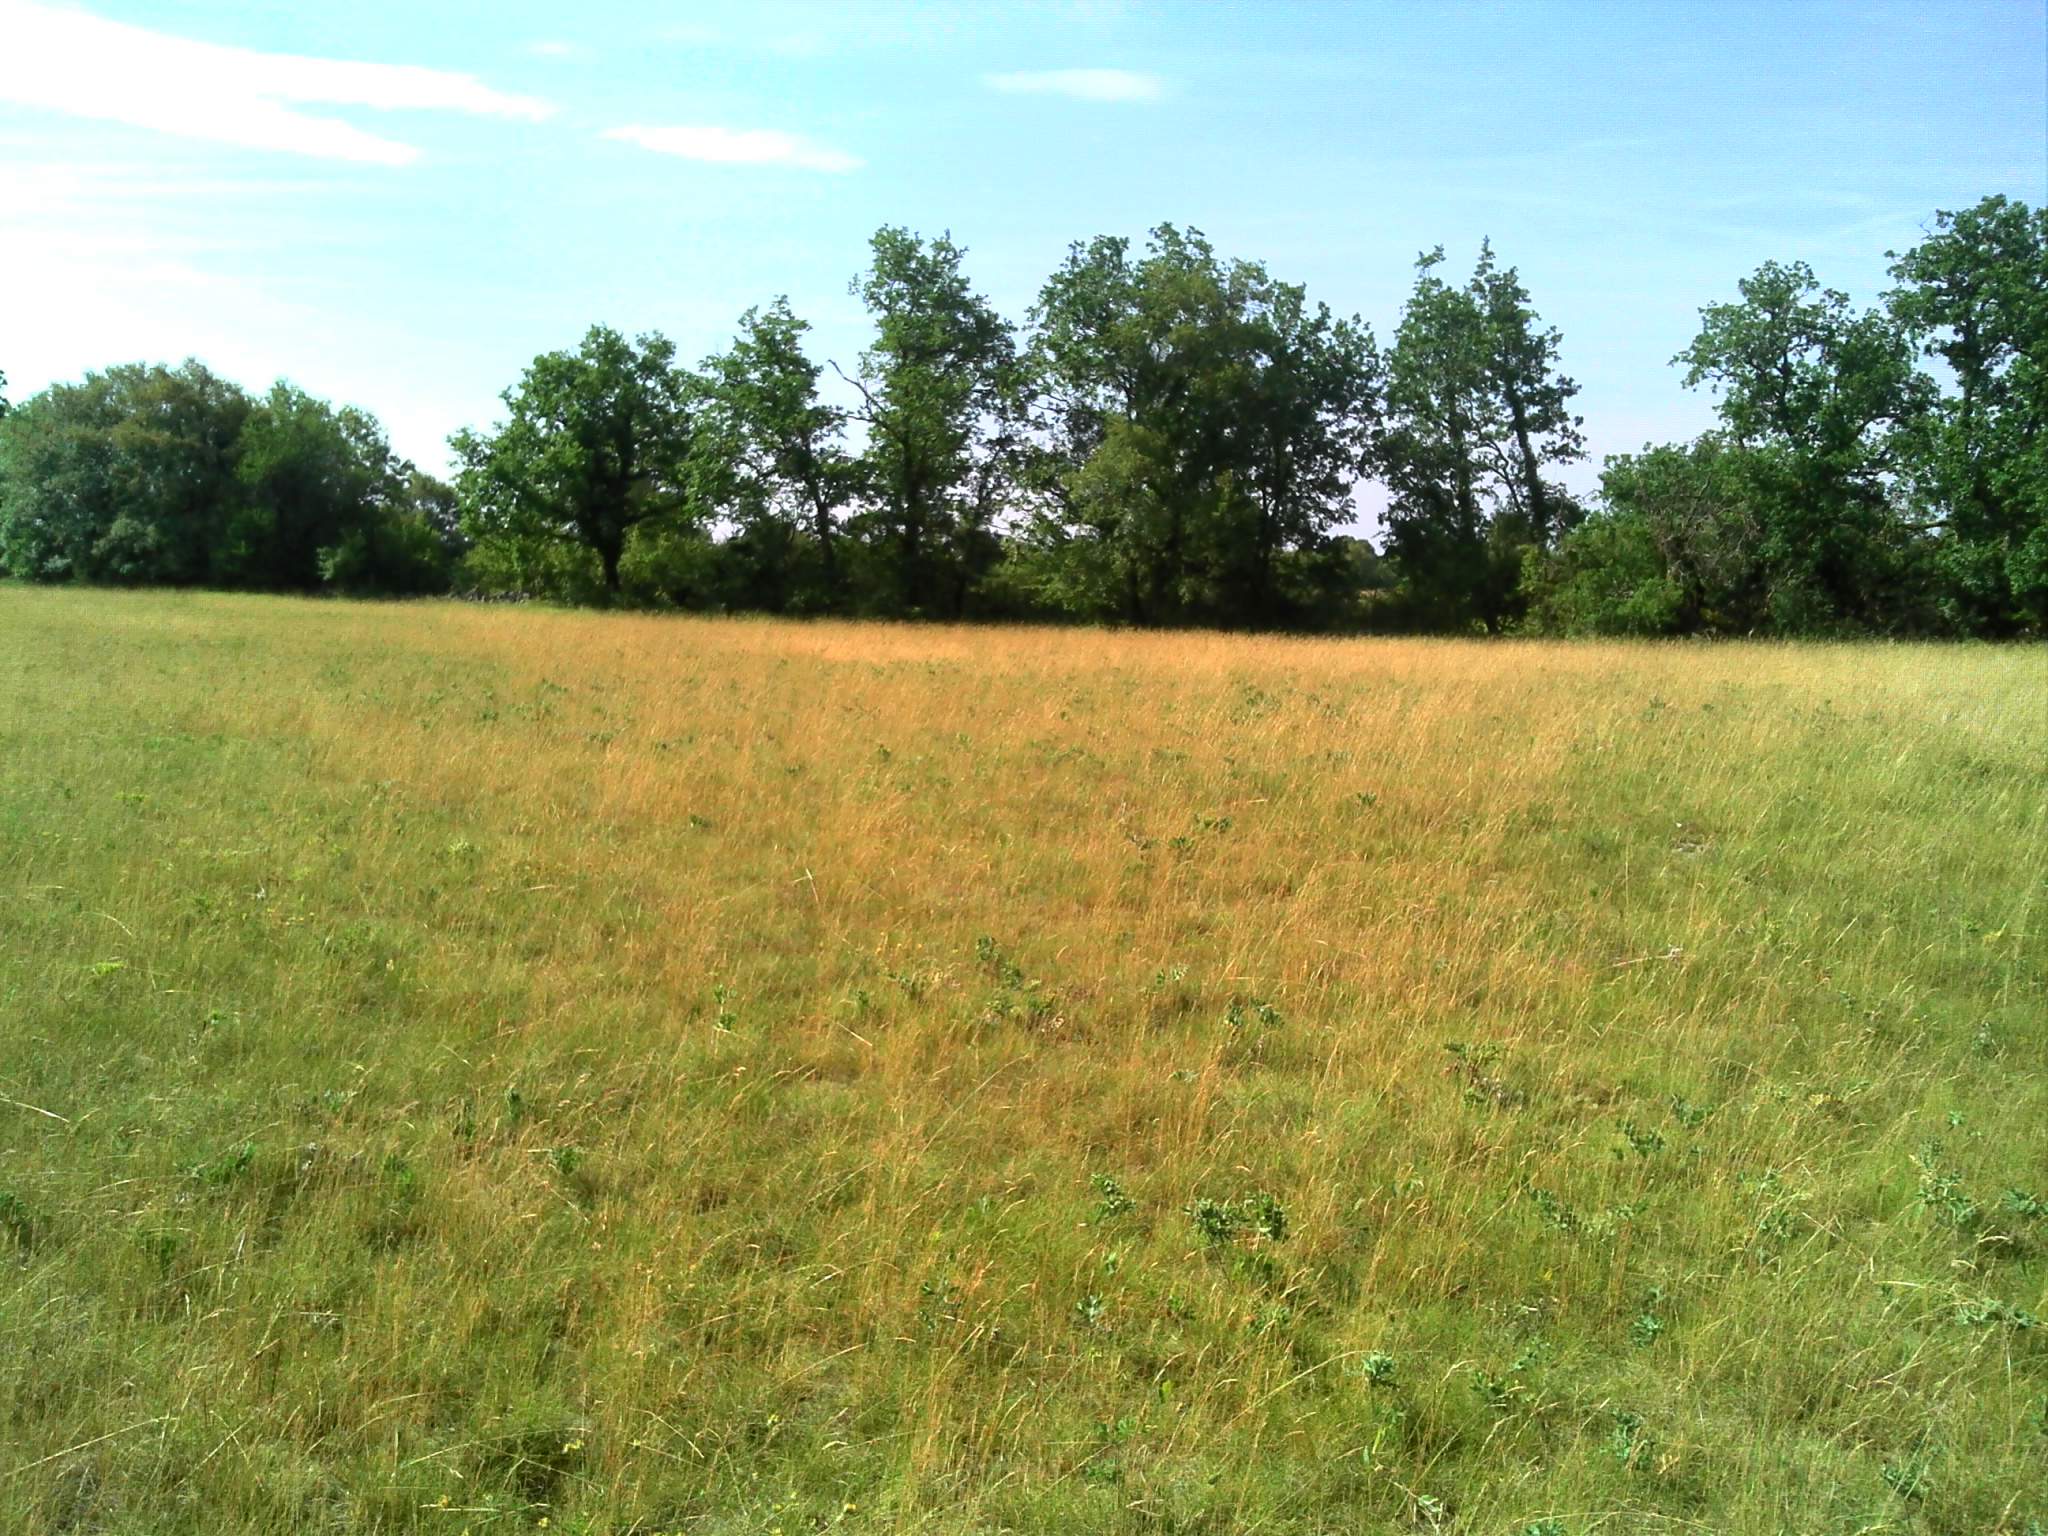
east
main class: Grassland
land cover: Grassland without tree/shrub cover
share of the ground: > 75 %
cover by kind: herbaceous plants 70 %, lichens and mosses 30 %
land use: Agriculture (excluding fallow land and kitchen gardens)
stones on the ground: 10 - 25 %
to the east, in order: Grassland without tree/shrub cover; Dry stone walls; Managed hedges; Grassland with sparse tree/shrub cover; Broadleaved woodland; Fences; Dry stone walls; Grass margins; Paved roads, cycling and walking lanes; Grass margins; Dry stone walls; Fences; Managed hedges; Fences; Grassland with sparse tree/shrub cover; Dry stone walls; Broadleaved woodland
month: June
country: FR
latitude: 44.6589
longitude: 1.7889
